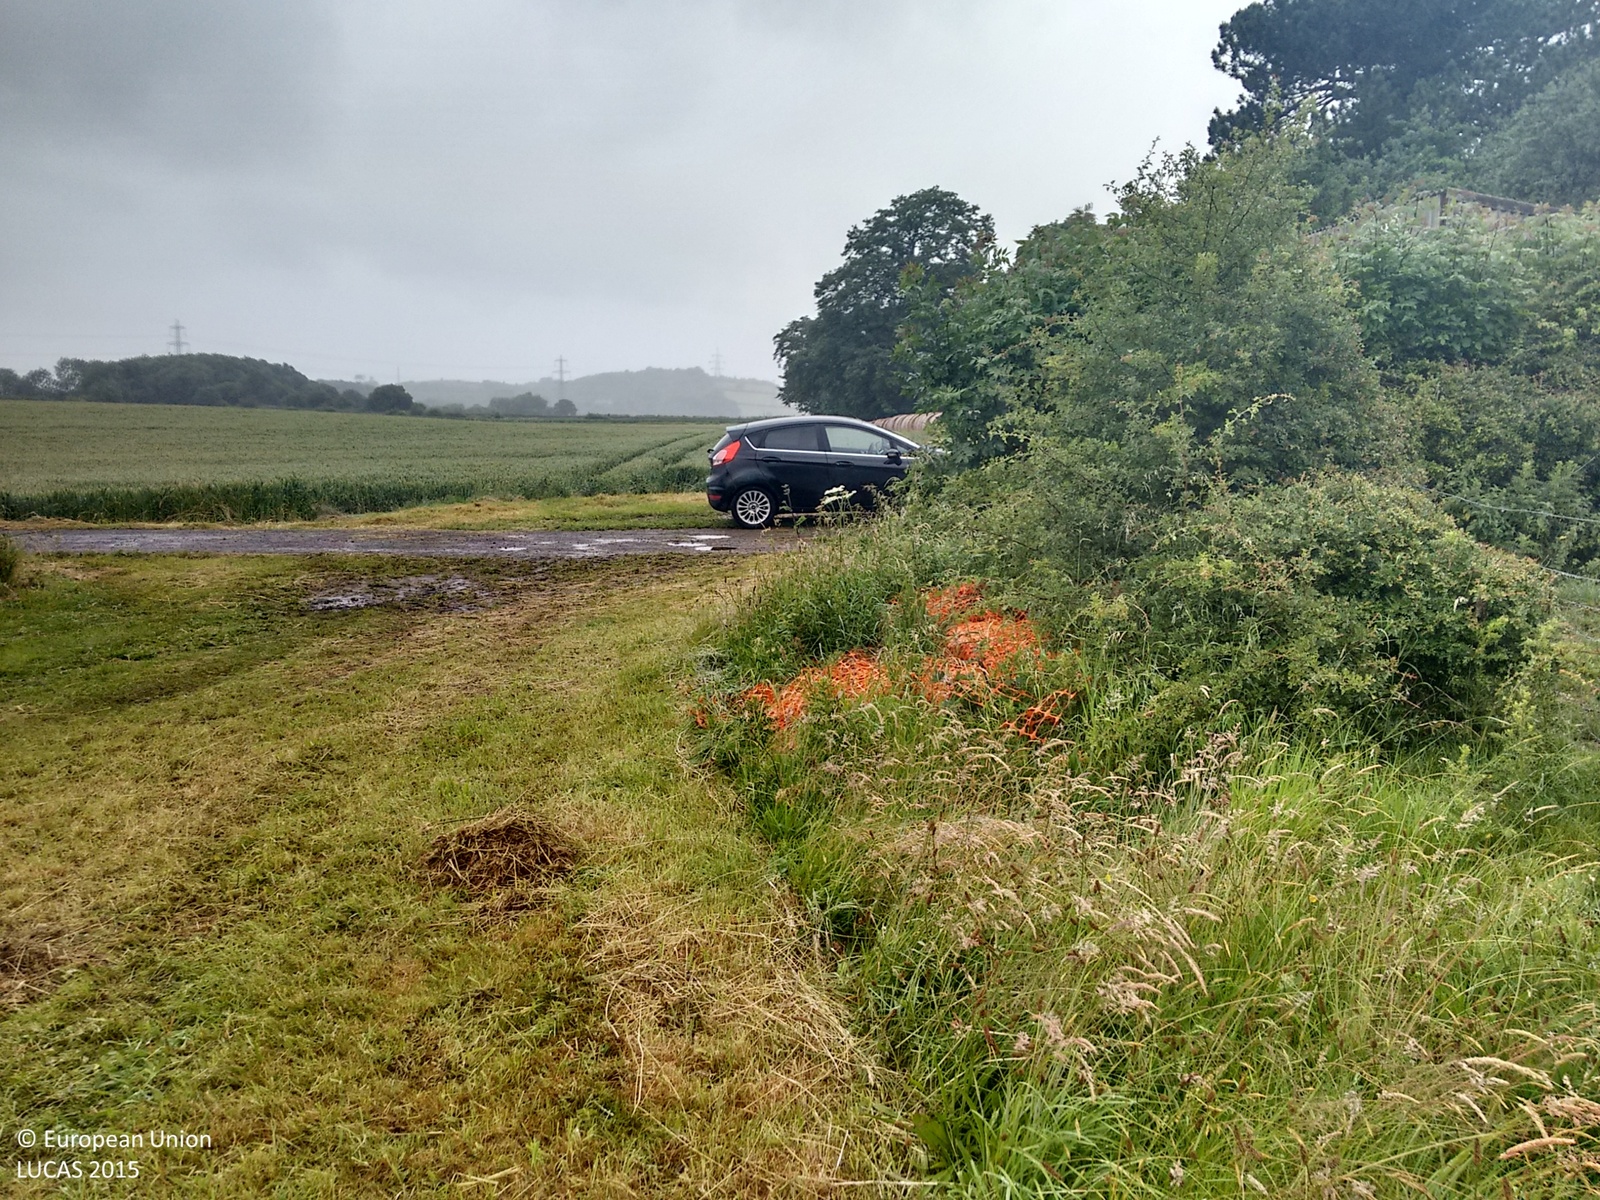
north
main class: Grassland
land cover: Grassland without tree/shrub cover
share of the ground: > 75 %
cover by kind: herbaceous plants 100 %
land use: Agriculture (excluding fallow land and kitchen gardens)
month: July
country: GB
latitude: 54.5194
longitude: -1.1513
